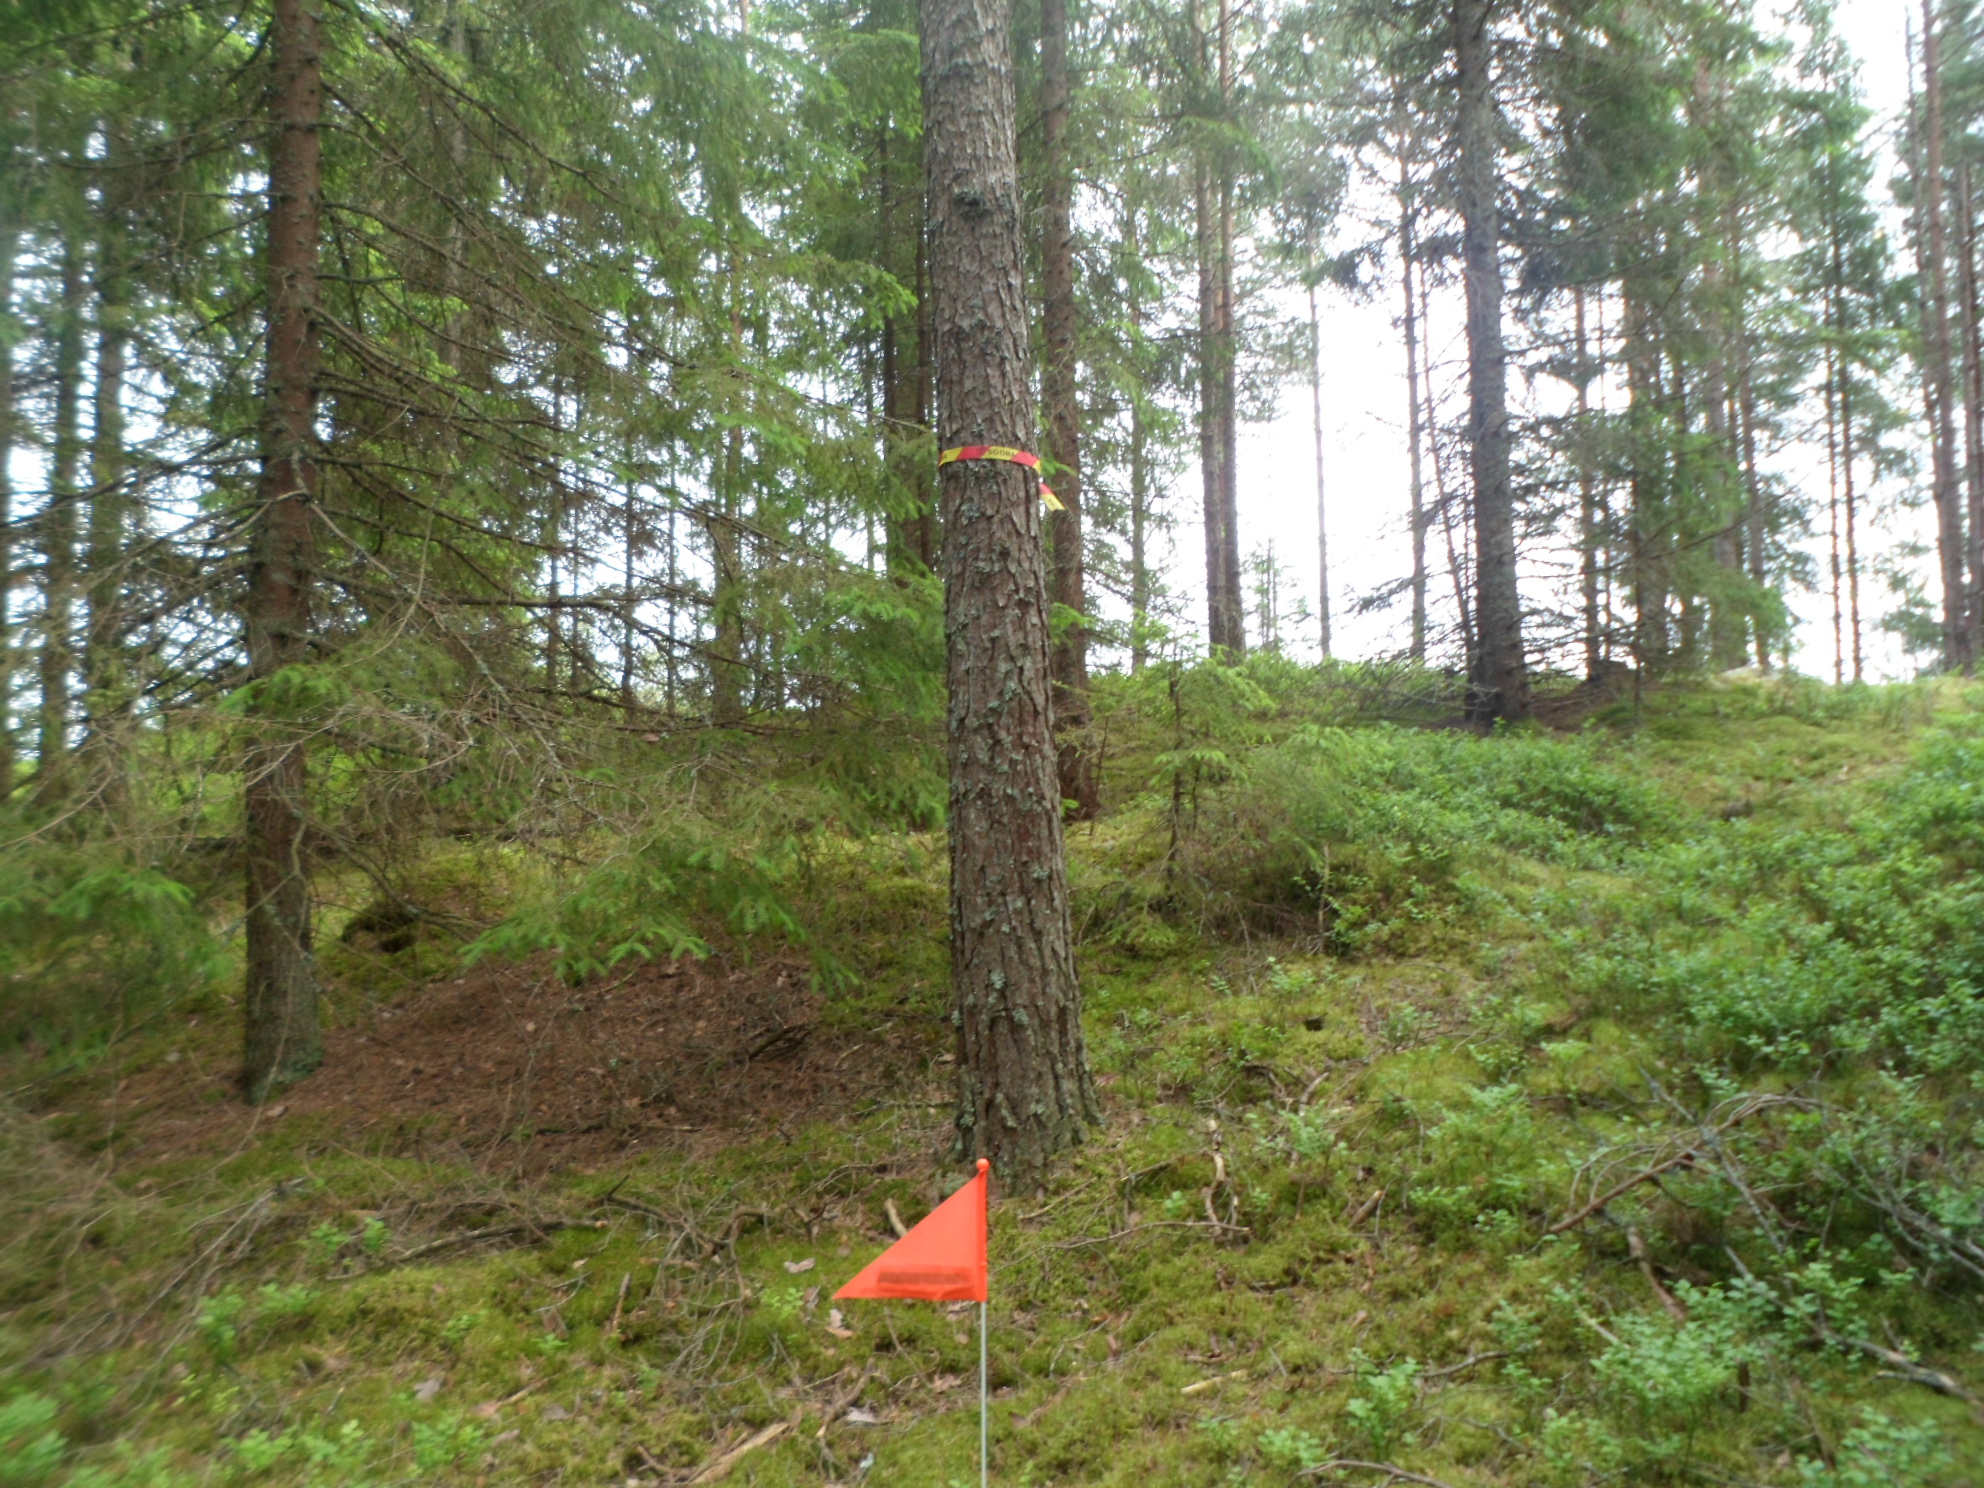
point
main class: Woodland
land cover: Pine dominated coniferous woodland
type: boreal forest
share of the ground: 50 - 75 %
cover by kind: coniferous forest trees 60 %, shrubs 20 %, lichens and mosses 20 %
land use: Forestry
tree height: > 5 m
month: June
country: SE
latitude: 56.9404
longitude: 15.3725
